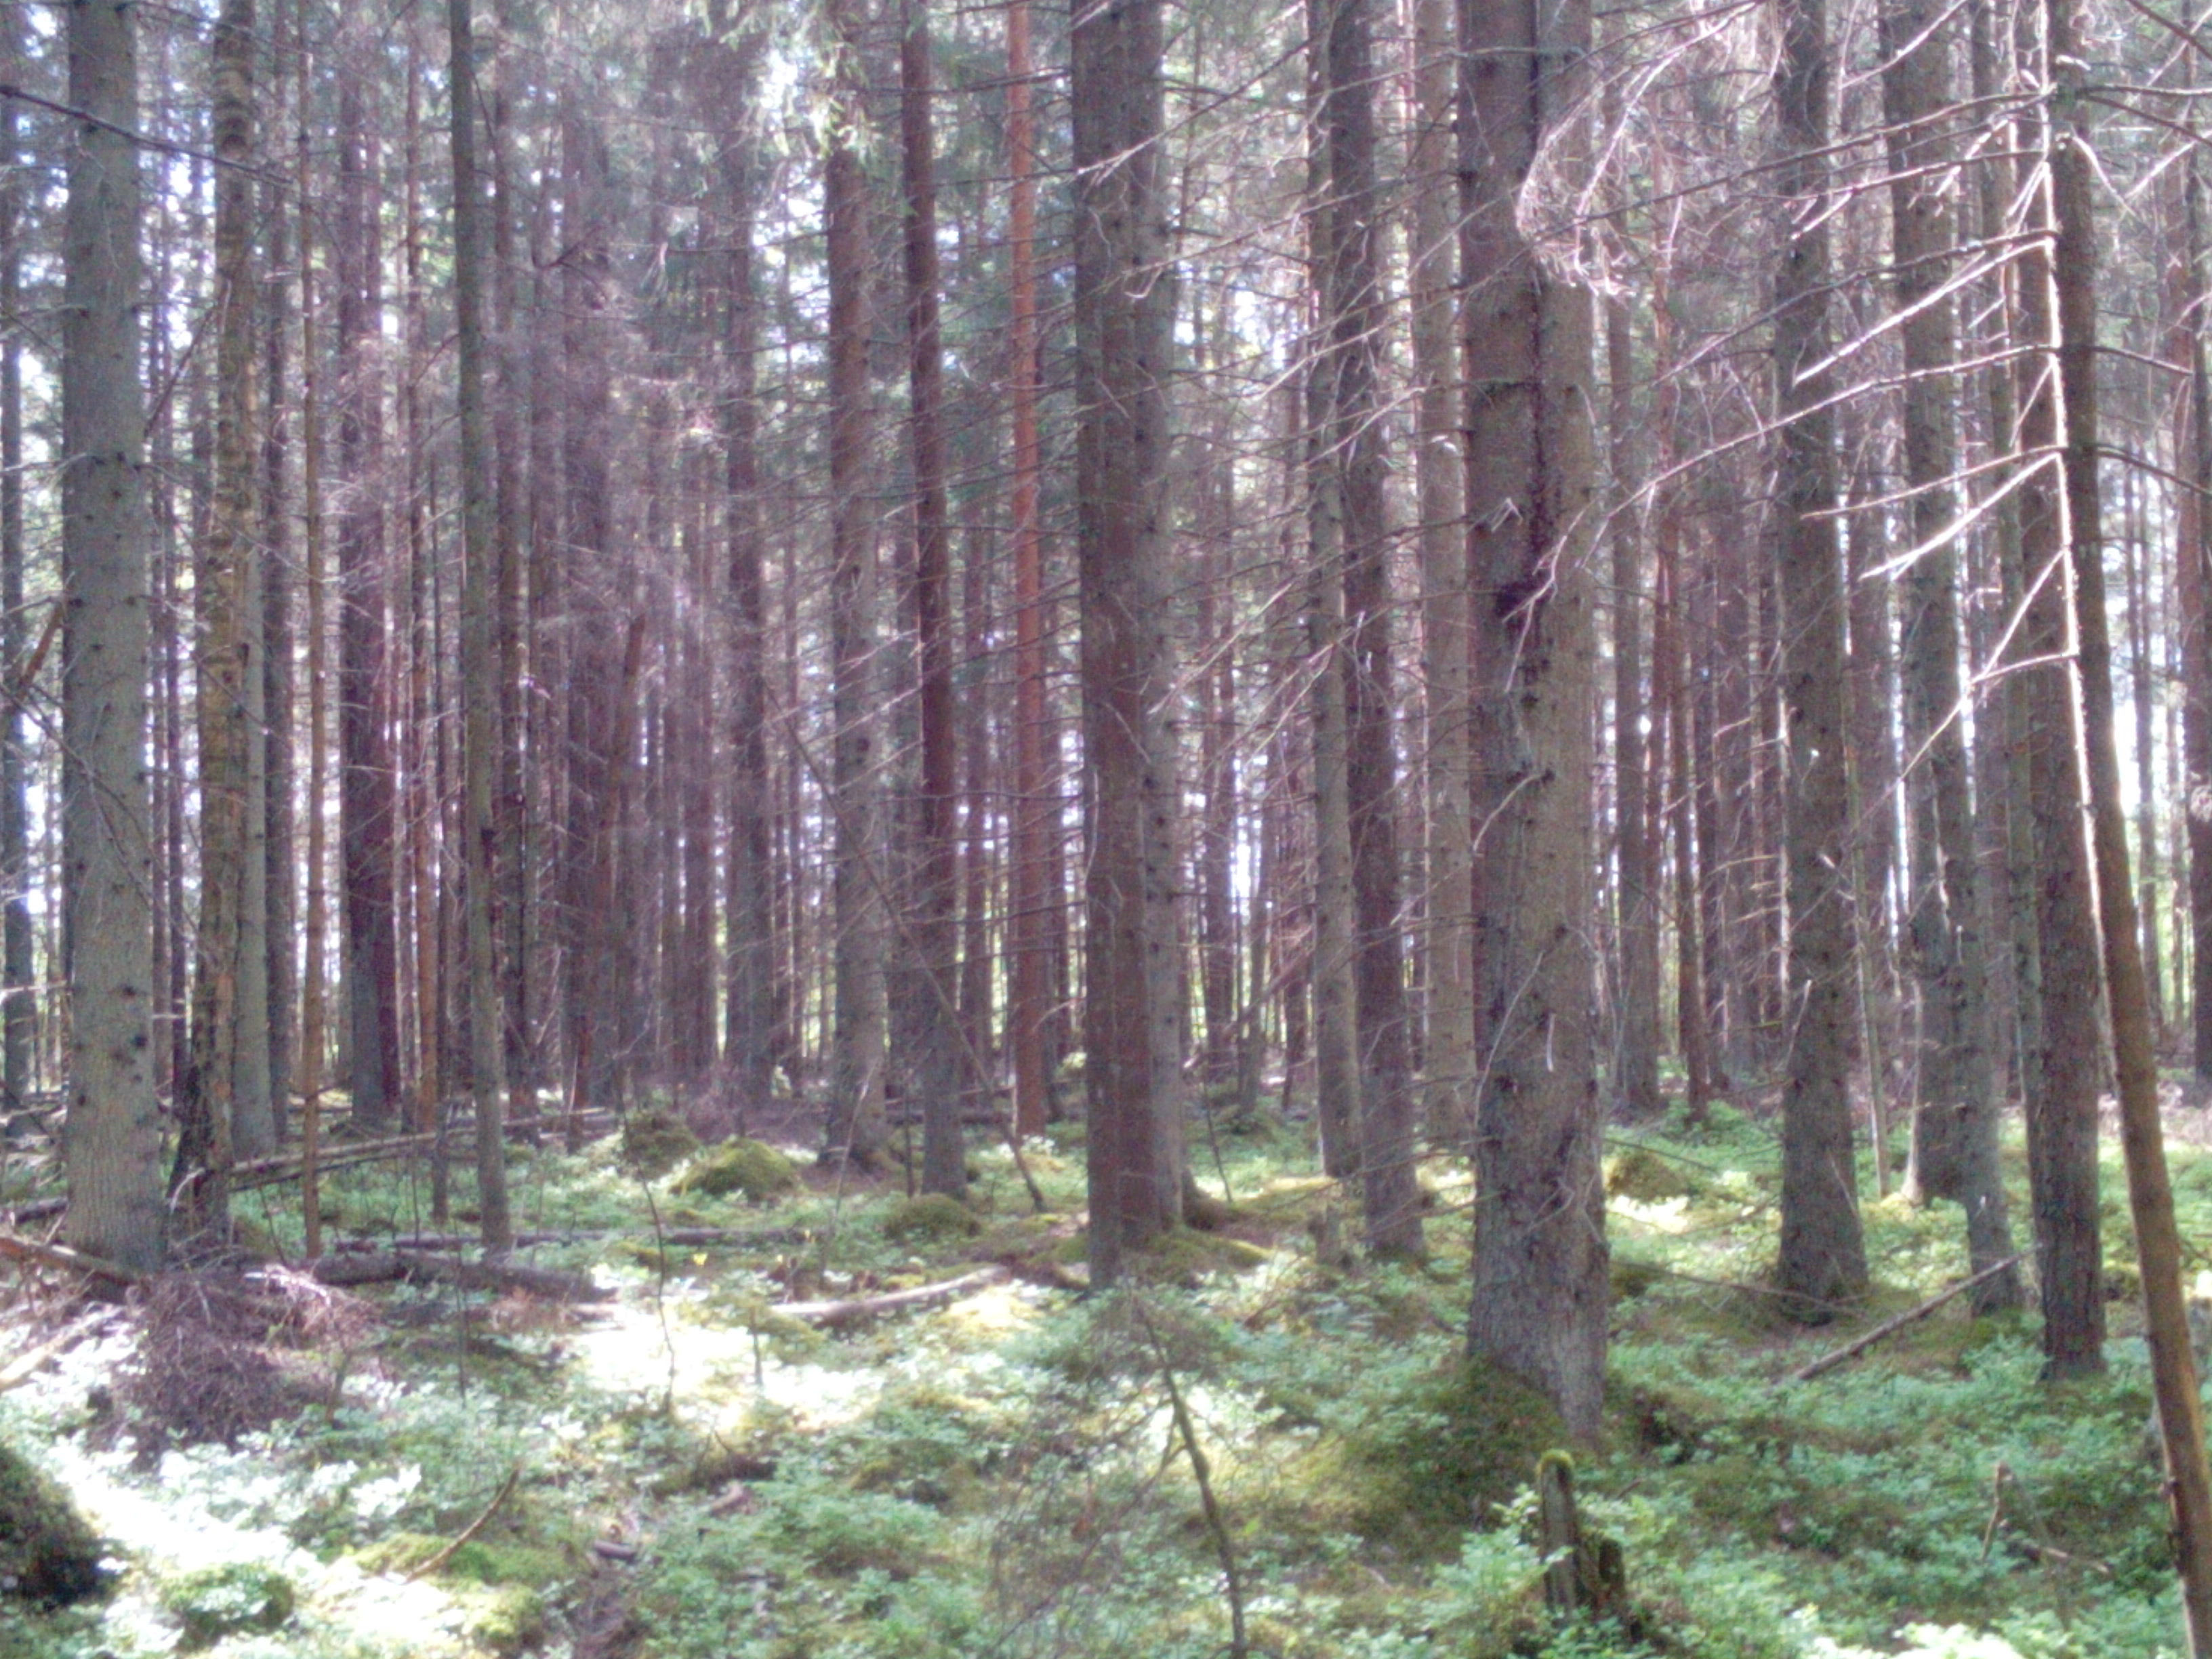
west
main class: Woodland
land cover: Spruce dominated coniferous woodland
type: hemiboreal forest and nemoral coniferous forest and mixed broadleaved-coniferous forest
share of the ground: > 75 %
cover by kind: coniferous forest trees 90 %, herbaceous plants 5 %, lichens and mosses 5 %
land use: Forestry
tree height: > 5 m
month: May
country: LV
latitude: 56.5550
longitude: 22.3374
